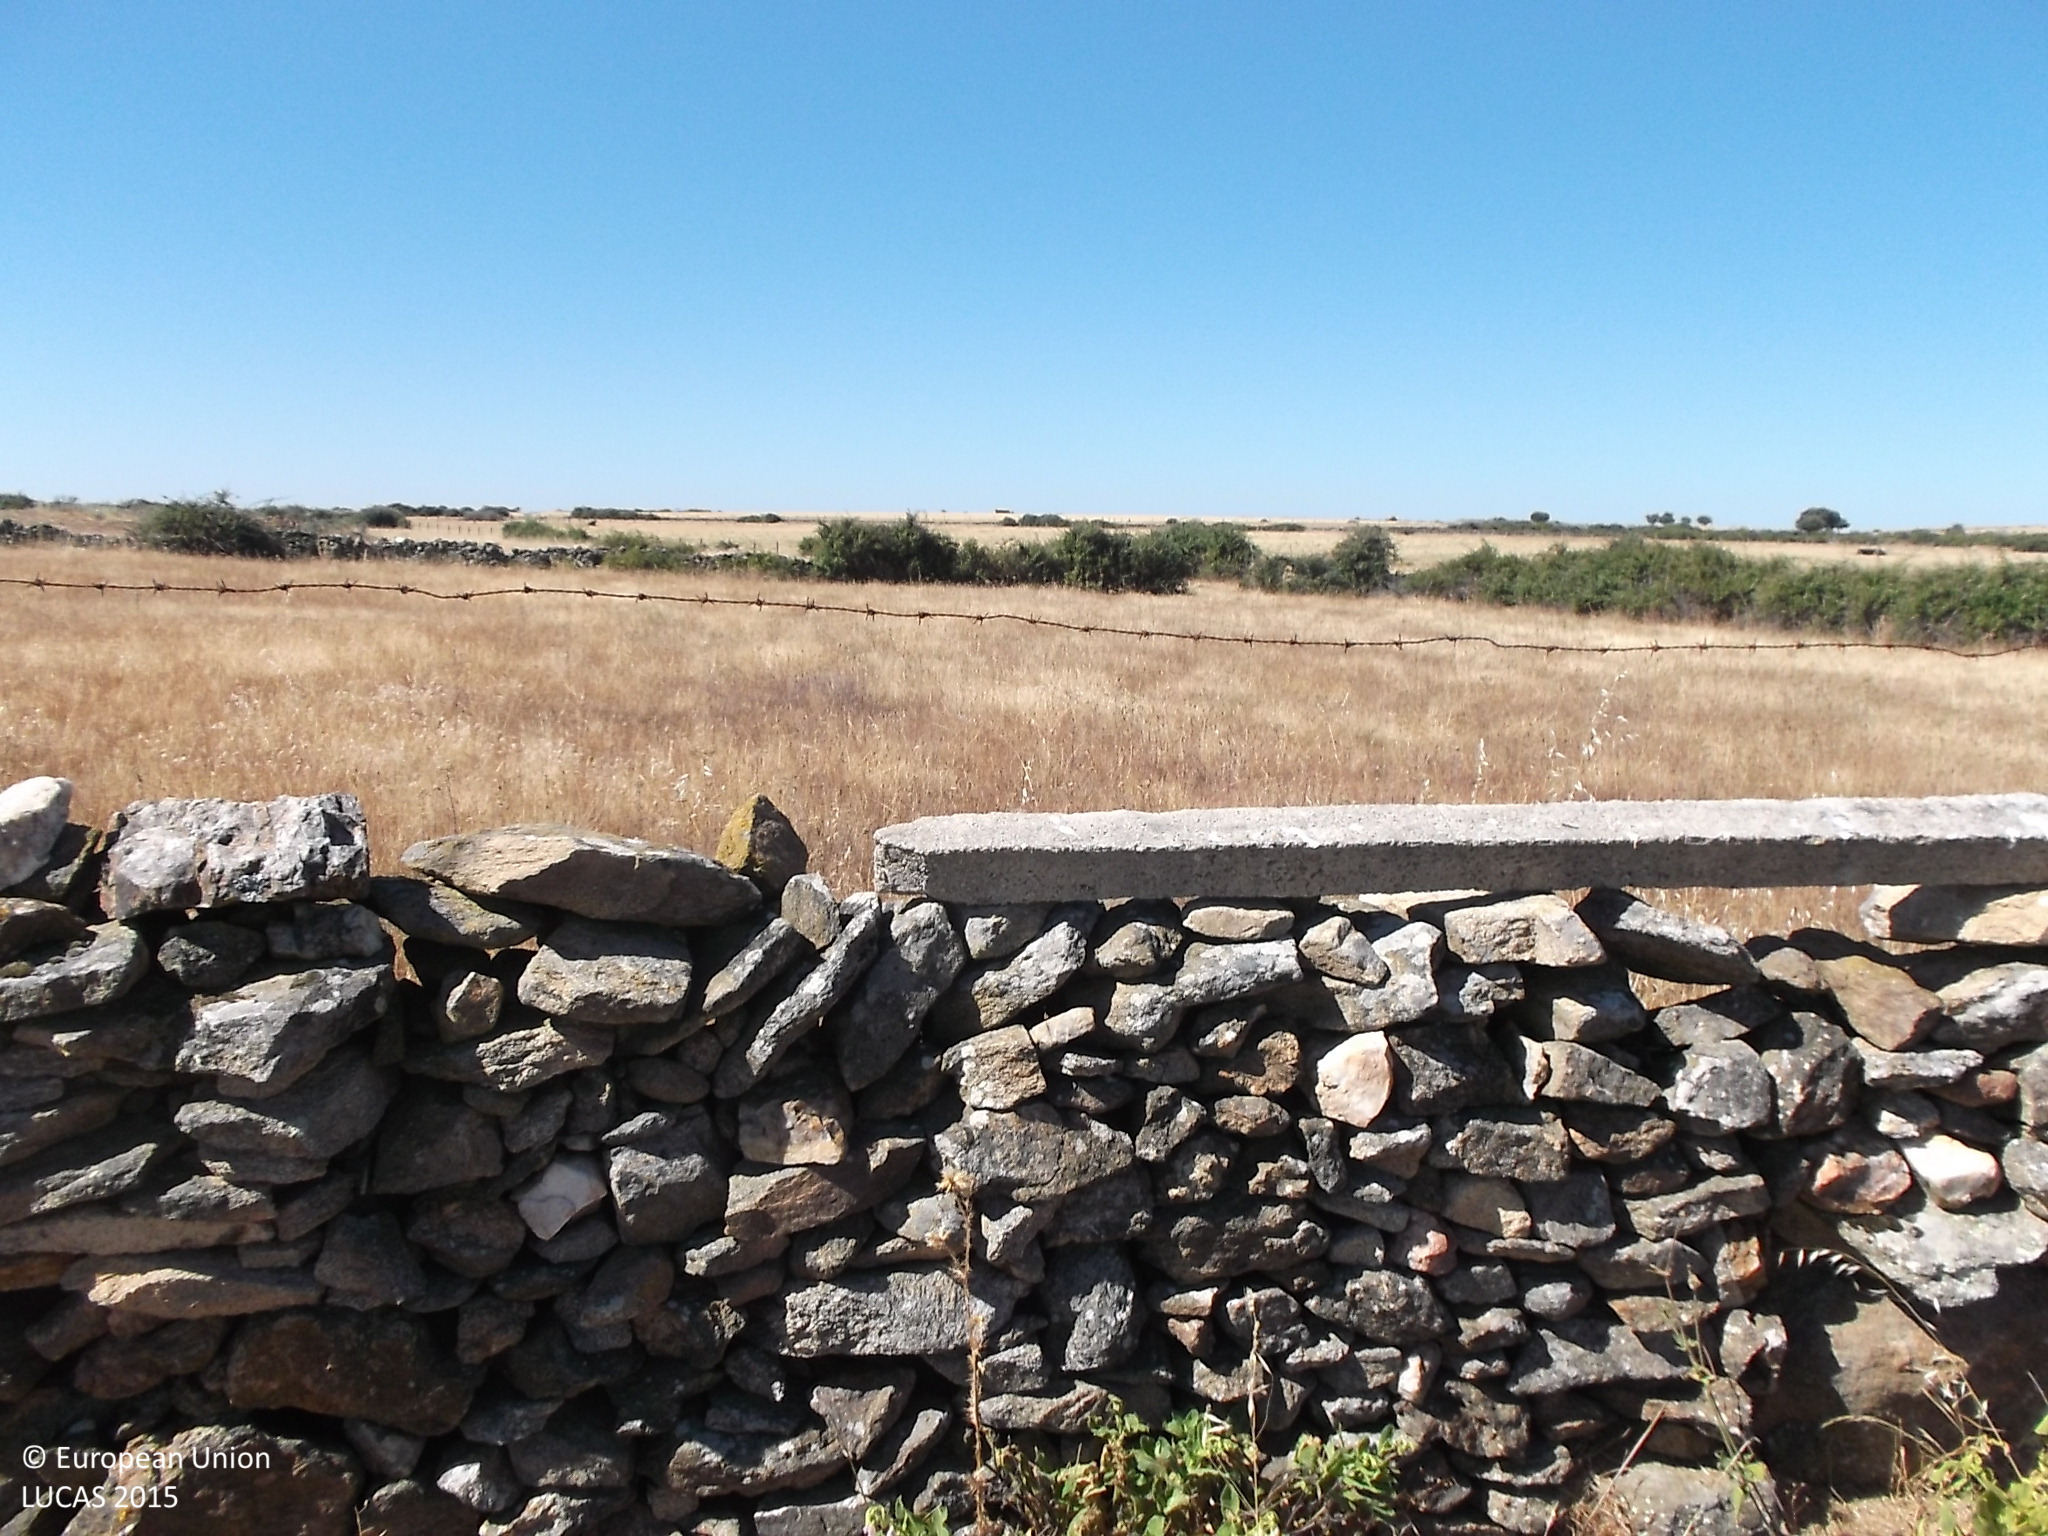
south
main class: Grassland
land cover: Grassland without tree/shrub cover
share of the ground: > 75 %
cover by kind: herbaceous plants 100 %
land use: Agriculture (excluding fallow land and kitchen gardens)
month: June
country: ES
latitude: 40.9108
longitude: -6.7811
